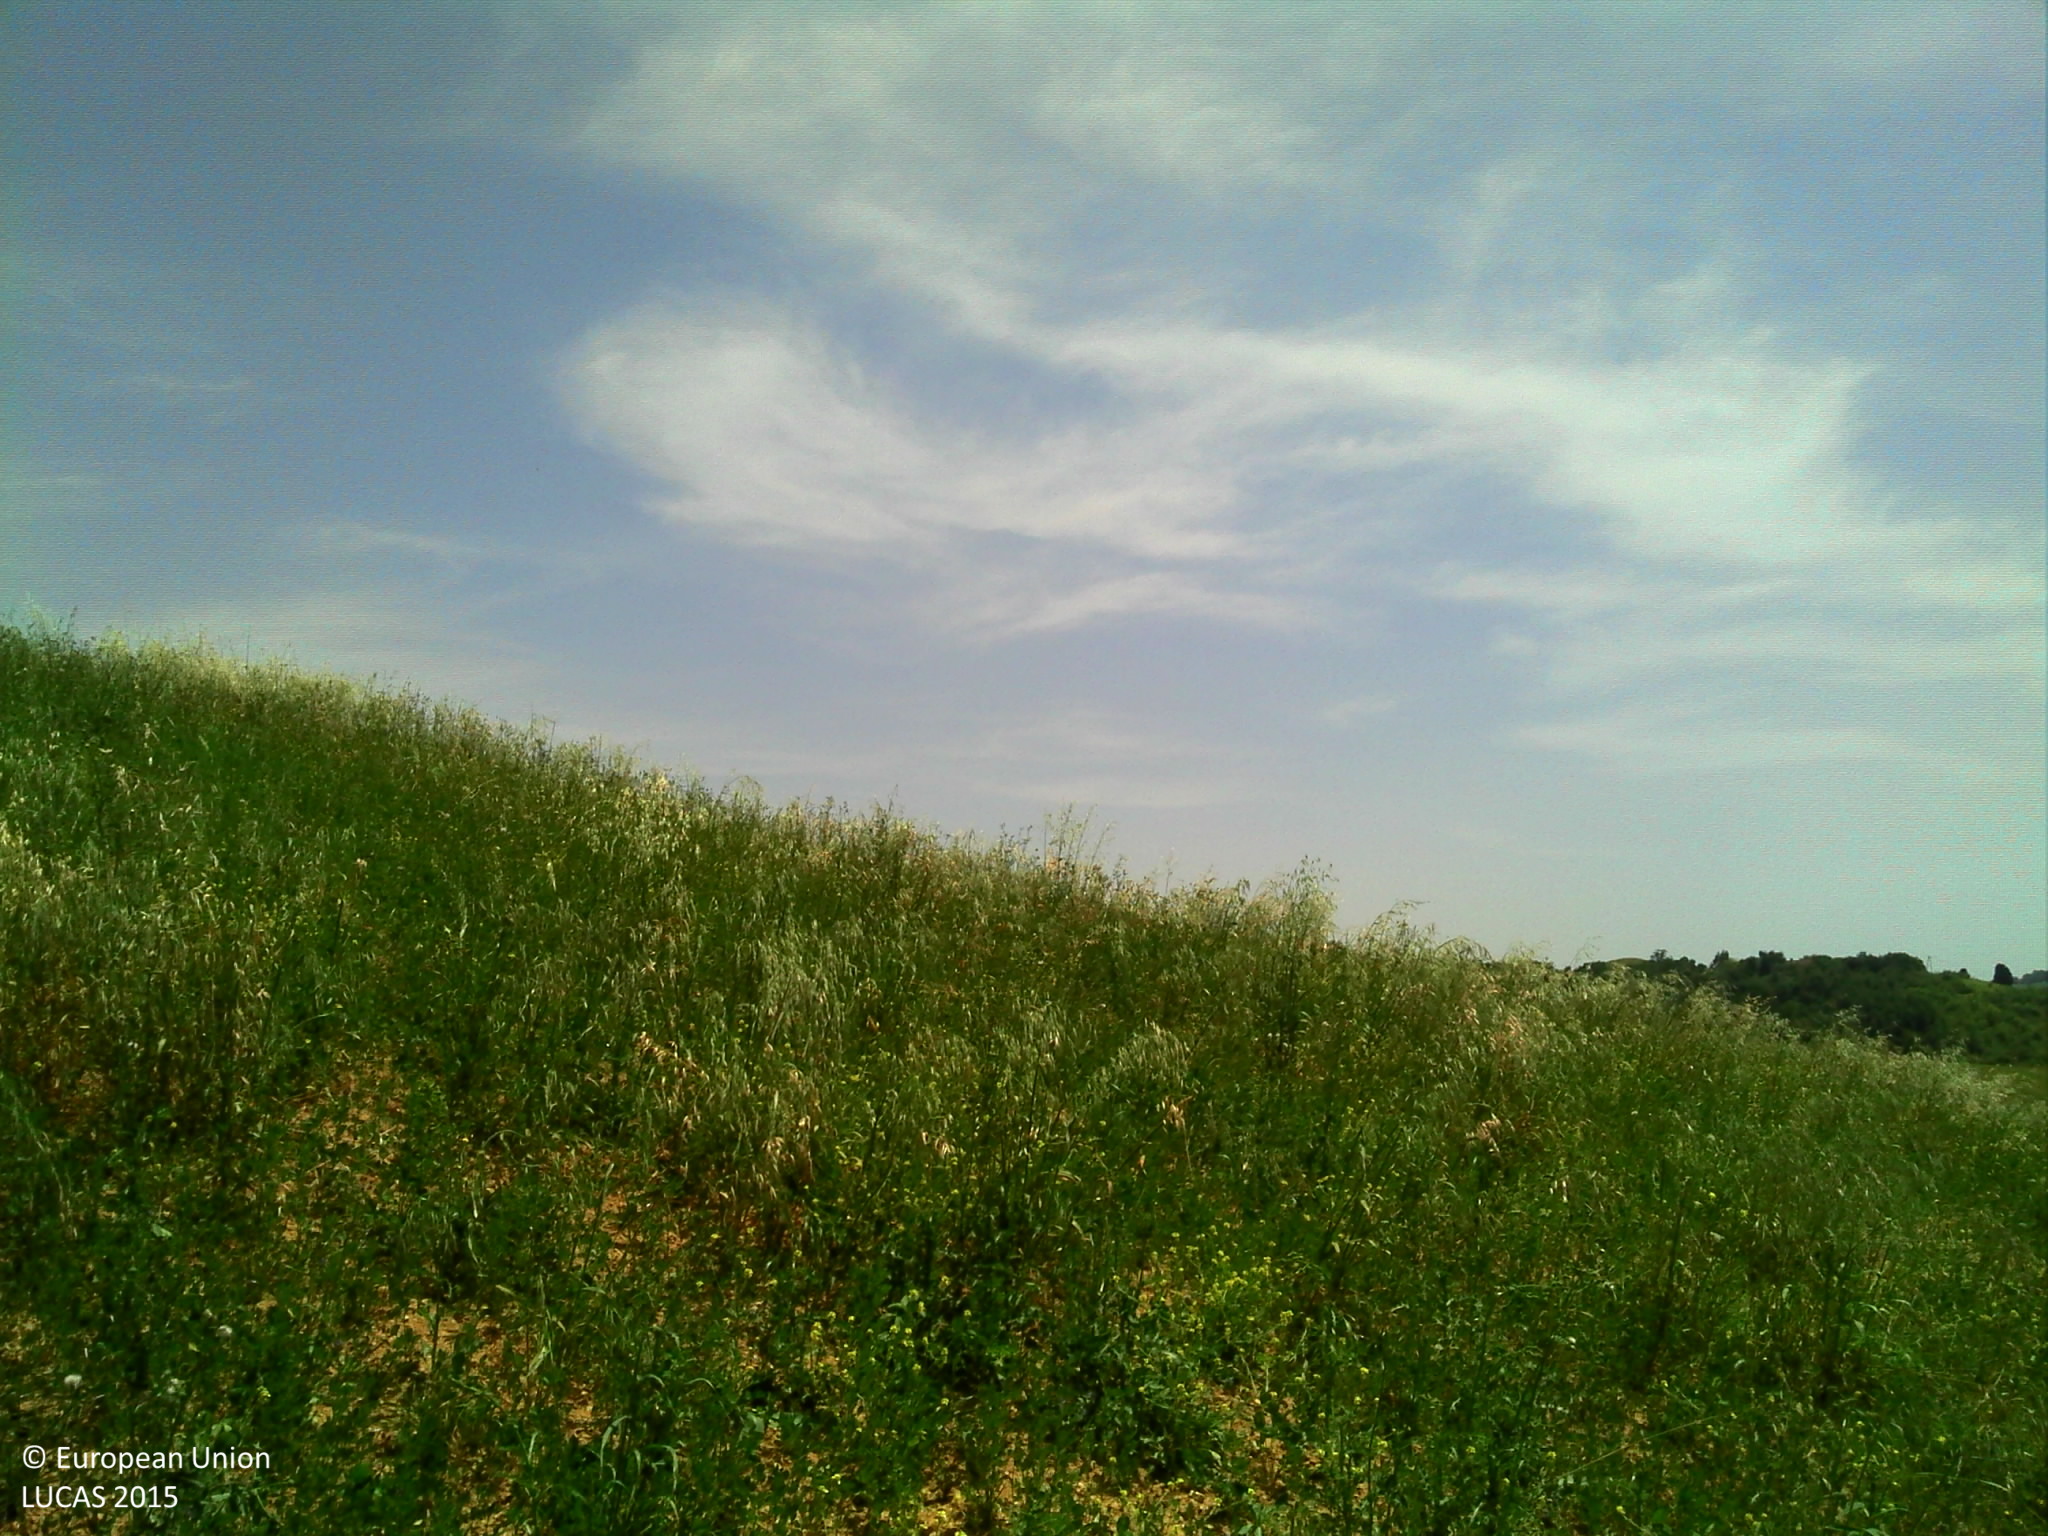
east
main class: Cropland
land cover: Other leguminous and mixtures for fodder
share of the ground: > 75 %
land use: Agriculture (excluding fallow land and kitchen gardens)
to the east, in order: Other leguminous and mixtures for fodder; Fences; Other leguminous and mixtures for fodder; Electric lines; Tracks; Lines of trees
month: July
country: FR
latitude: 43.1835
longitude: 1.4788
